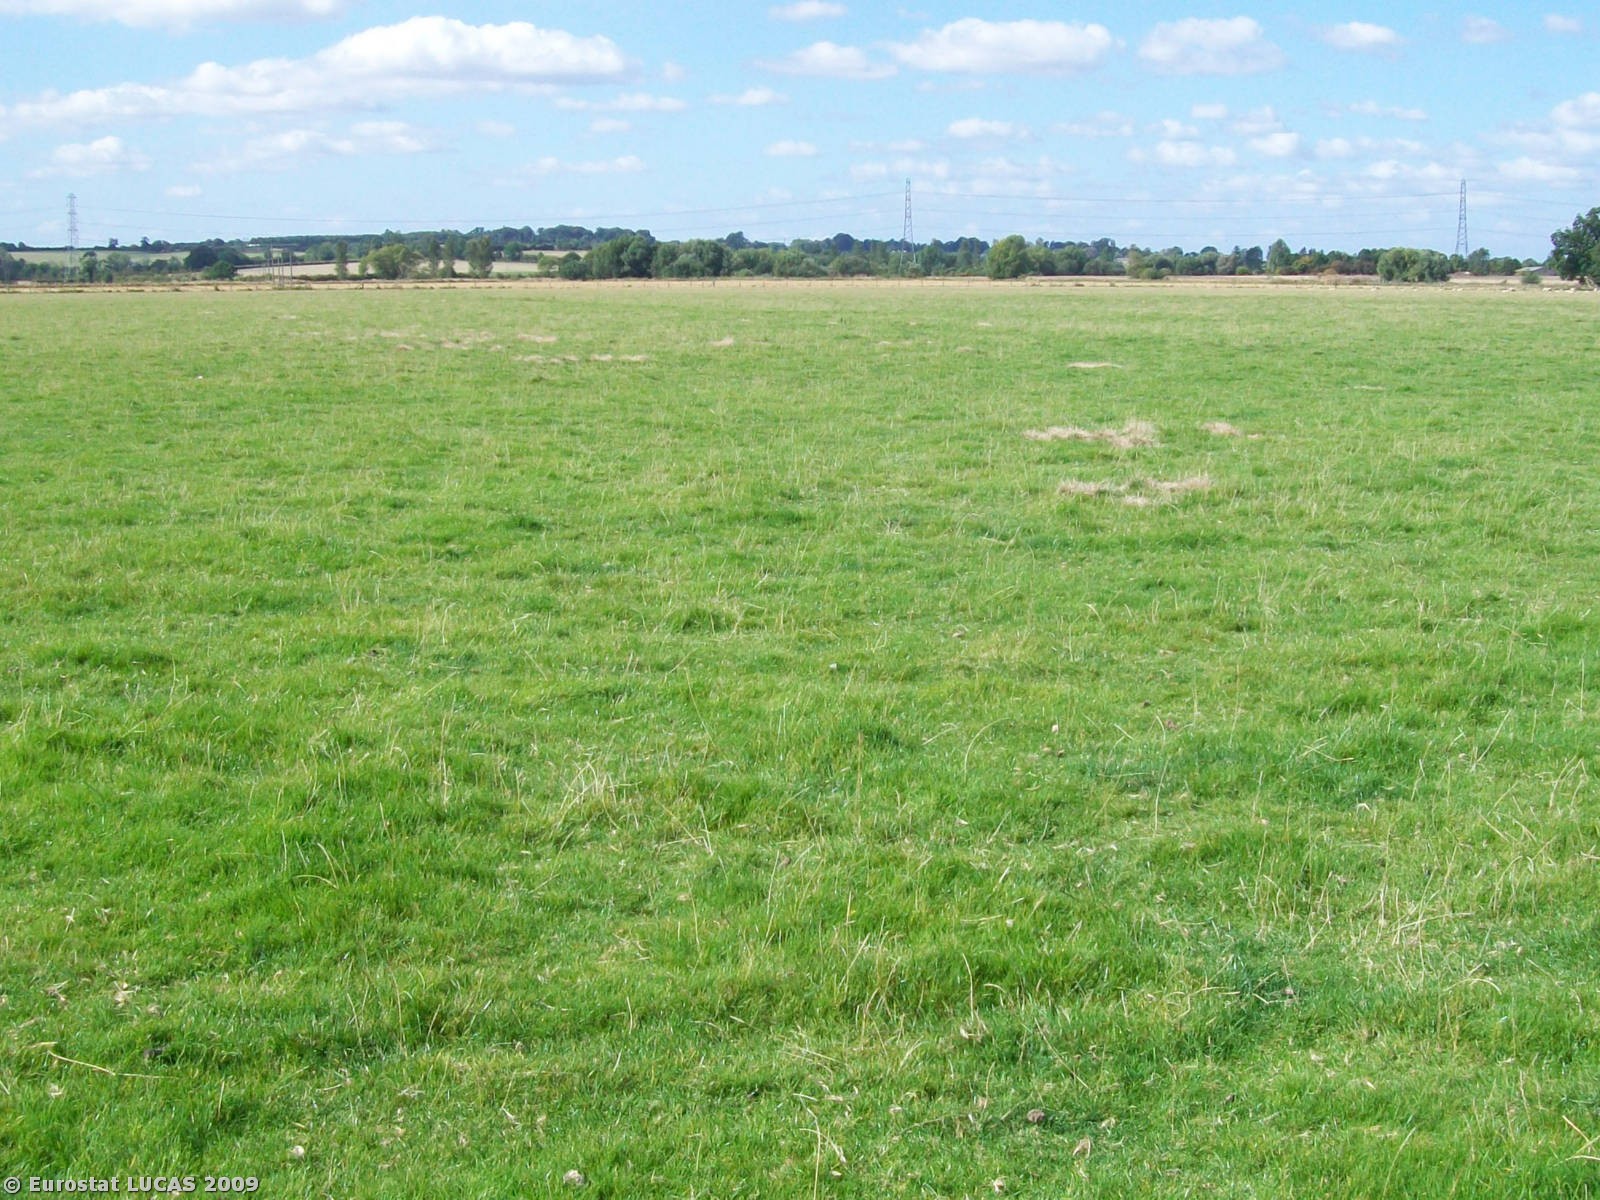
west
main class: Grassland
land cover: Grassland without tree/shrub cover
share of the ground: > 75 %
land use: Agriculture (excluding fallow land and kitchen gardens)
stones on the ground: < 10 %
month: September
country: GB
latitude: 52.1256
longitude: -0.9255
